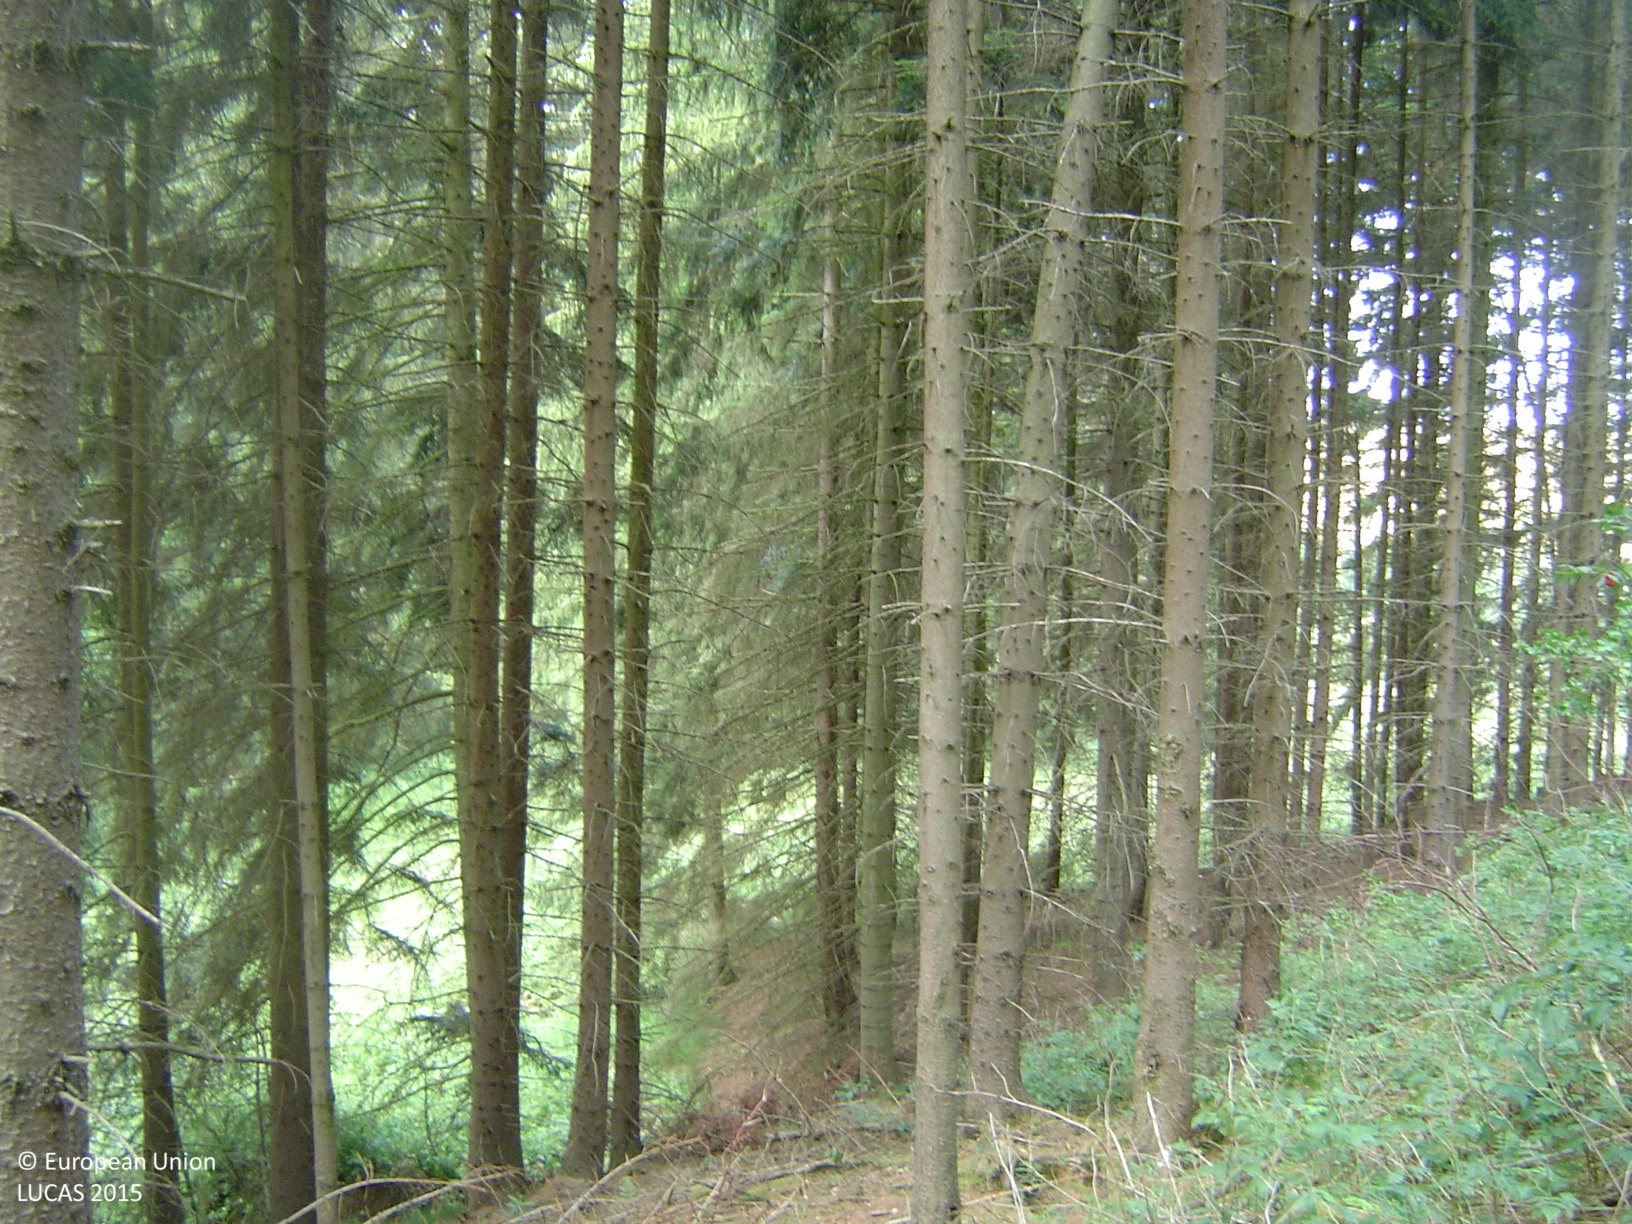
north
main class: Woodland
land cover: Spruce dominated coniferous woodland
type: hemiboreal forest and nemoral coniferous forest and mixed broadleaved-coniferous forest
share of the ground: > 75 %
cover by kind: coniferous forest trees 90 %, shrubs 5 %, herbaceous plants 5 %
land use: Forestry
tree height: > 5 m
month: July
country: CZ
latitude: 49.2906
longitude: 16.2620
